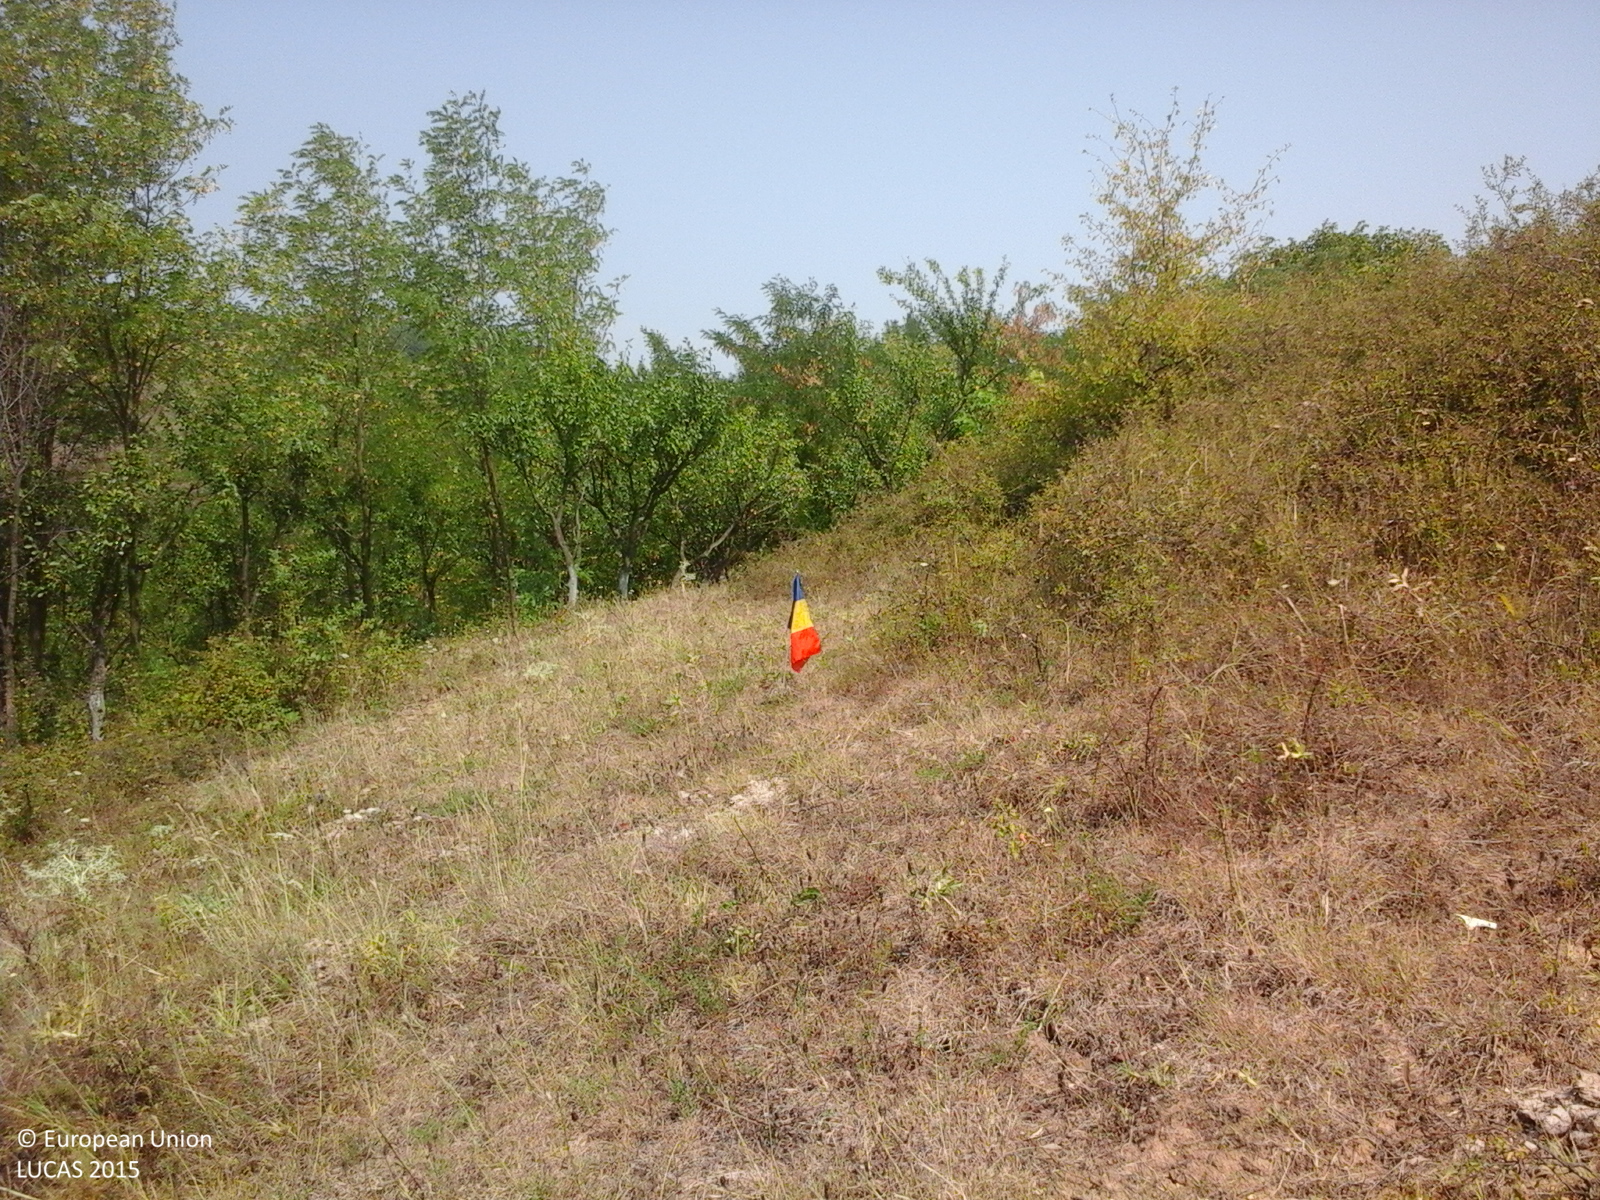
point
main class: Shrubland
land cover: Shrubland without tree cover
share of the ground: > 75 %
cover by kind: shrubs 90 %, herbaceous plants 10 %
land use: Agriculture (excluding fallow land and kitchen gardens)
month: August
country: RO
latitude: 44.6446
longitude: 23.6870
